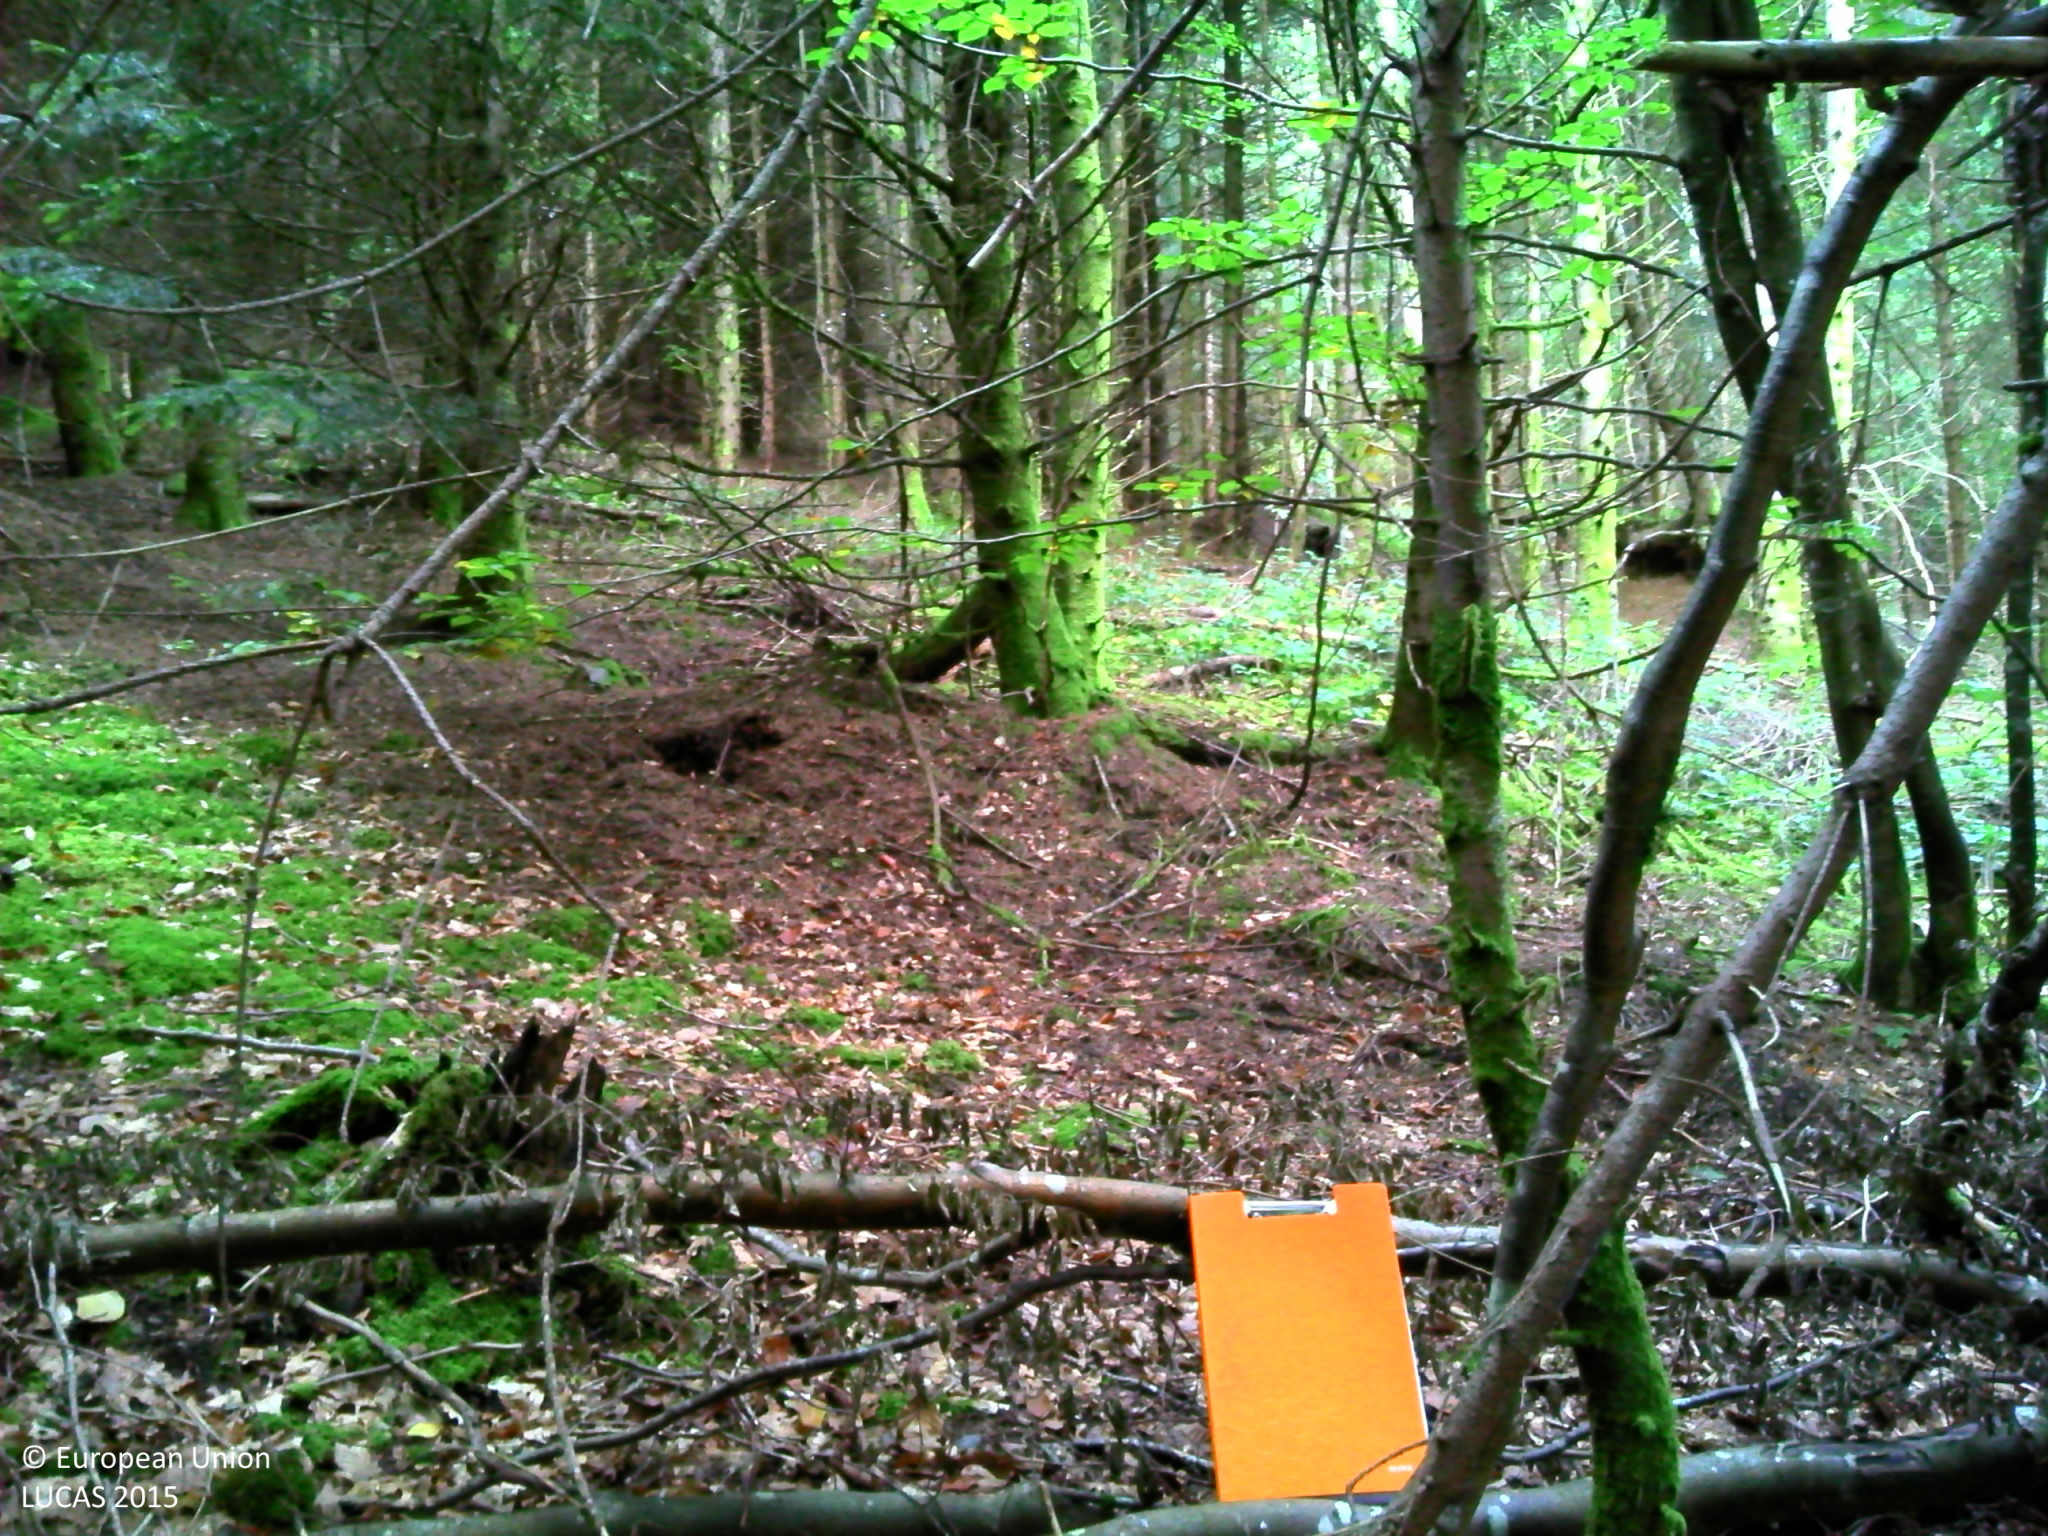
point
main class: Woodland
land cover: Other coniferous woodland
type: exotic forest
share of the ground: 50 - 75 %
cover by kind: coniferous forest trees 60 %, lichens and mosses 30 %, broadleaved forest trees 5 %, herbaceous plants 5 %
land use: Forestry
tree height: > 5 m
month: October
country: FR
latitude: 45.9090
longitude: 2.7920
